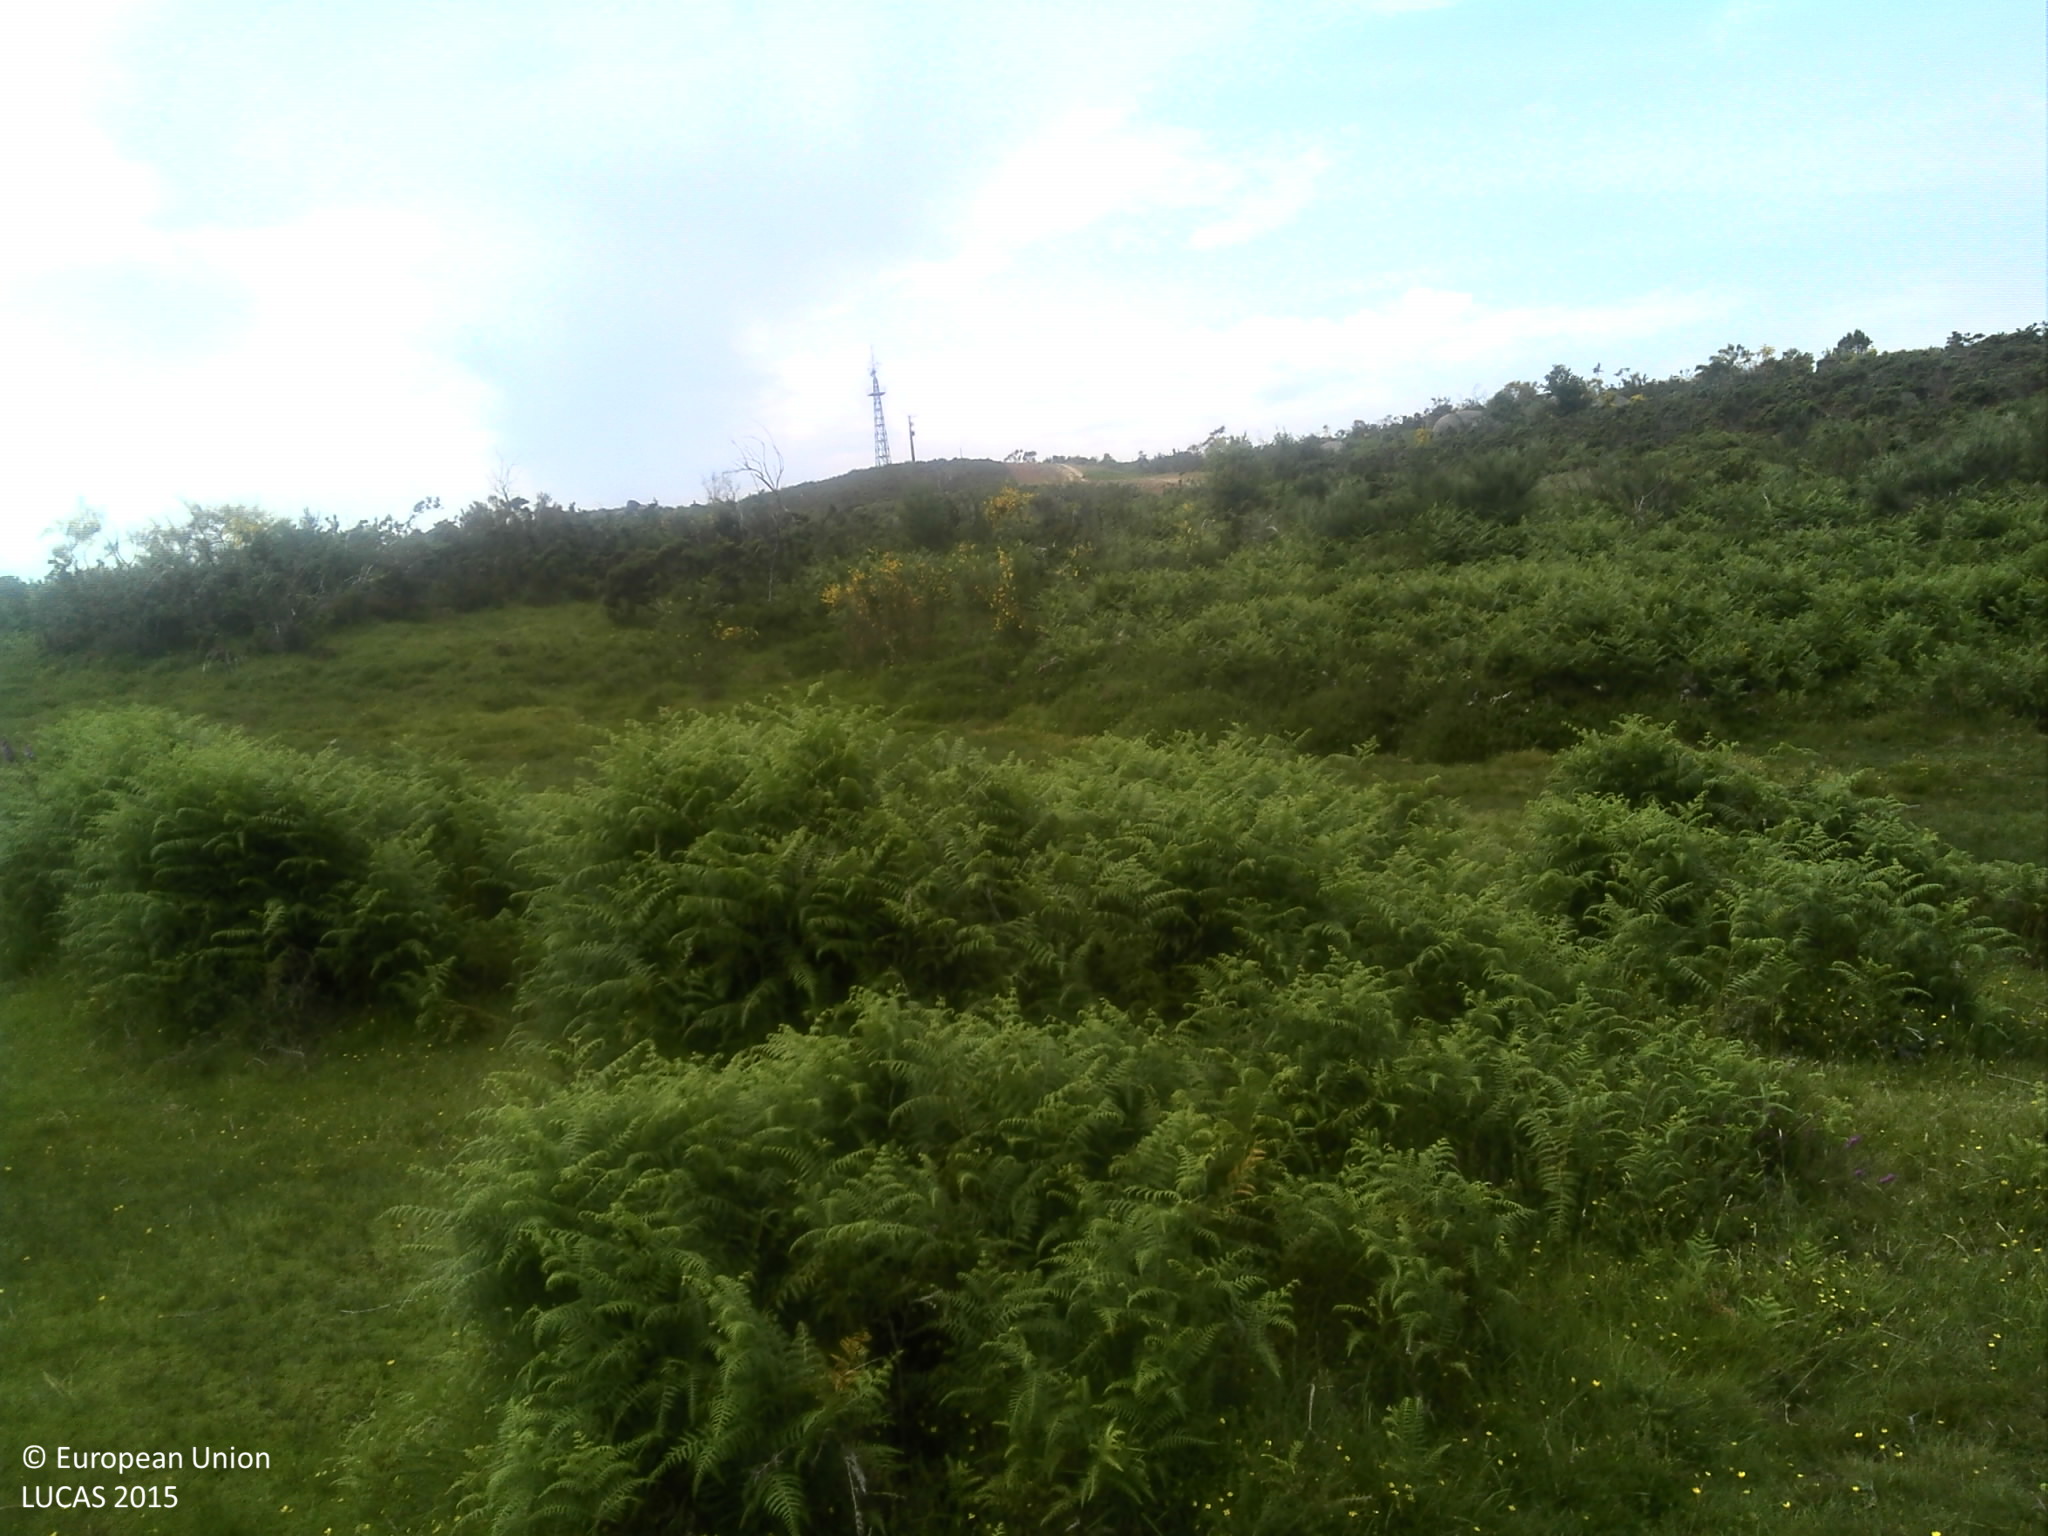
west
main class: Shrubland
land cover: Shrubland without tree cover
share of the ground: > 75 %
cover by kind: shrubs 60 %, herbaceous plants 35 %, unconsolidated bare surface 5 %
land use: Agriculture (excluding fallow land and kitchen gardens)
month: June
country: PT
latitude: 41.7328
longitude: -8.3694
